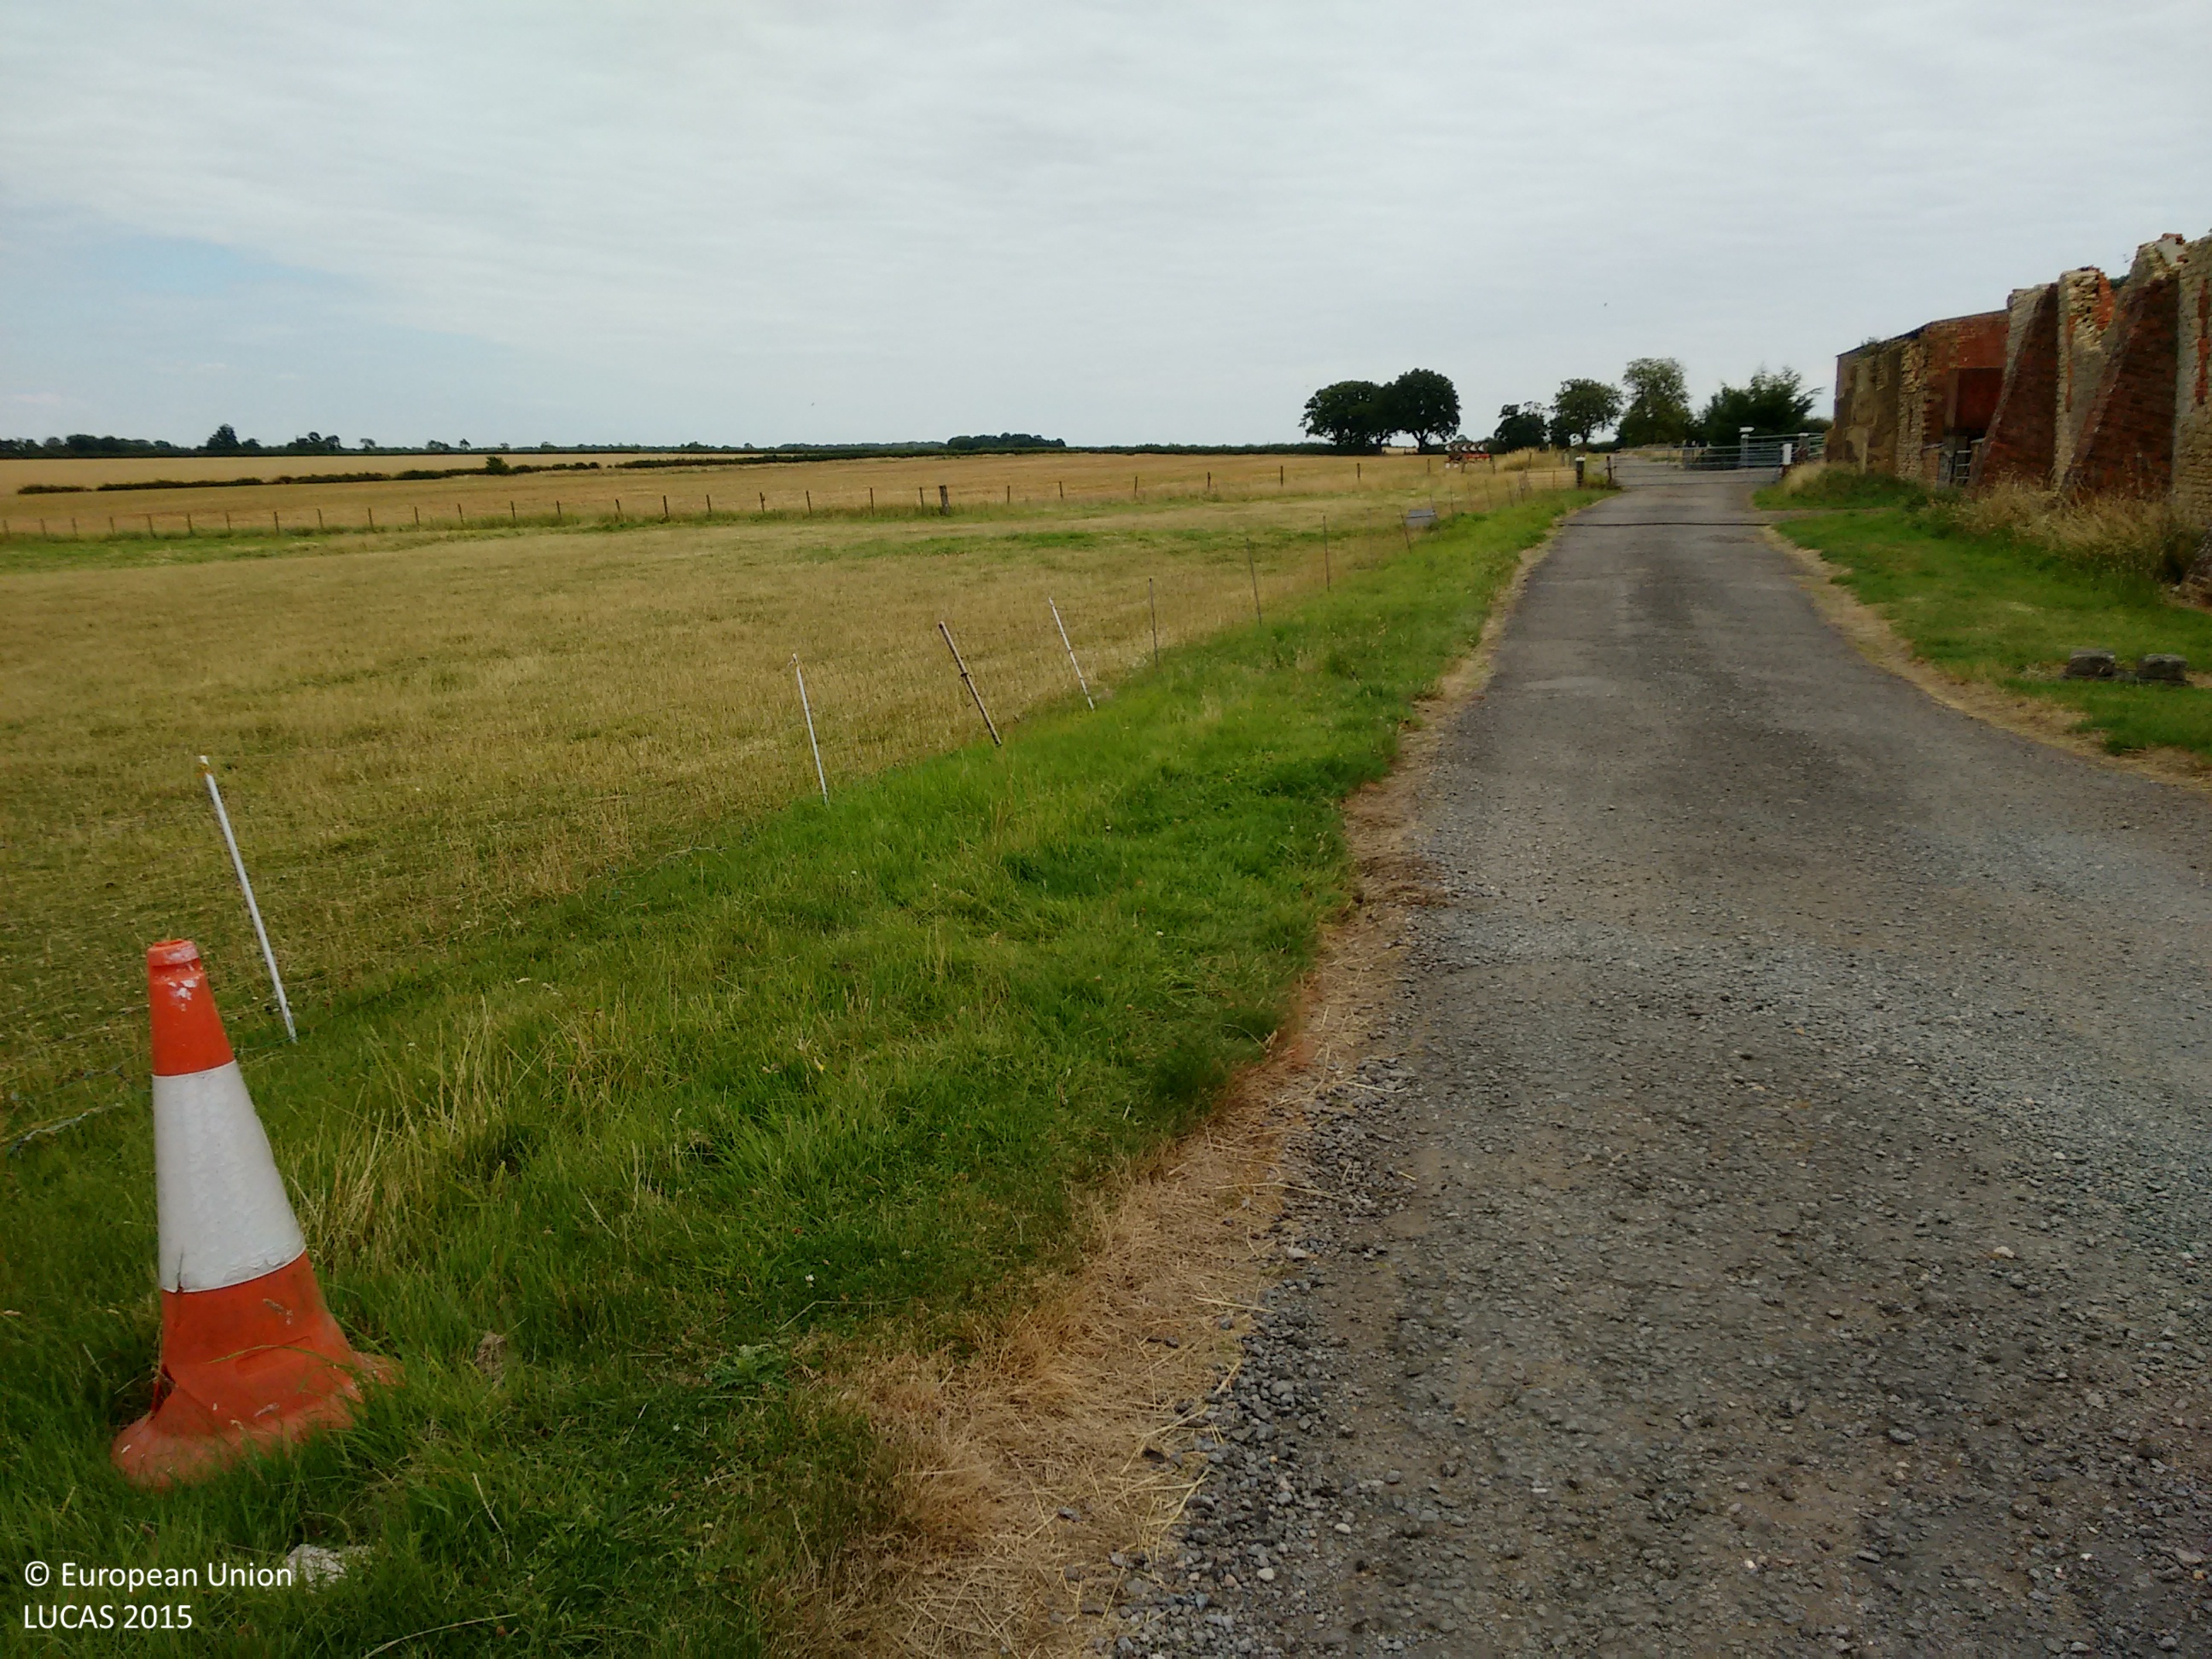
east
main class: Grassland
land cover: Grassland without tree/shrub cover
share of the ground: > 75 %
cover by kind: herbaceous plants 100 %
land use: Agriculture (excluding fallow land and kitchen gardens)
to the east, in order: Grassland without tree/shrub cover; Tracks; Grass margins
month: August
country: GB
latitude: 52.2028
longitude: -0.6779
